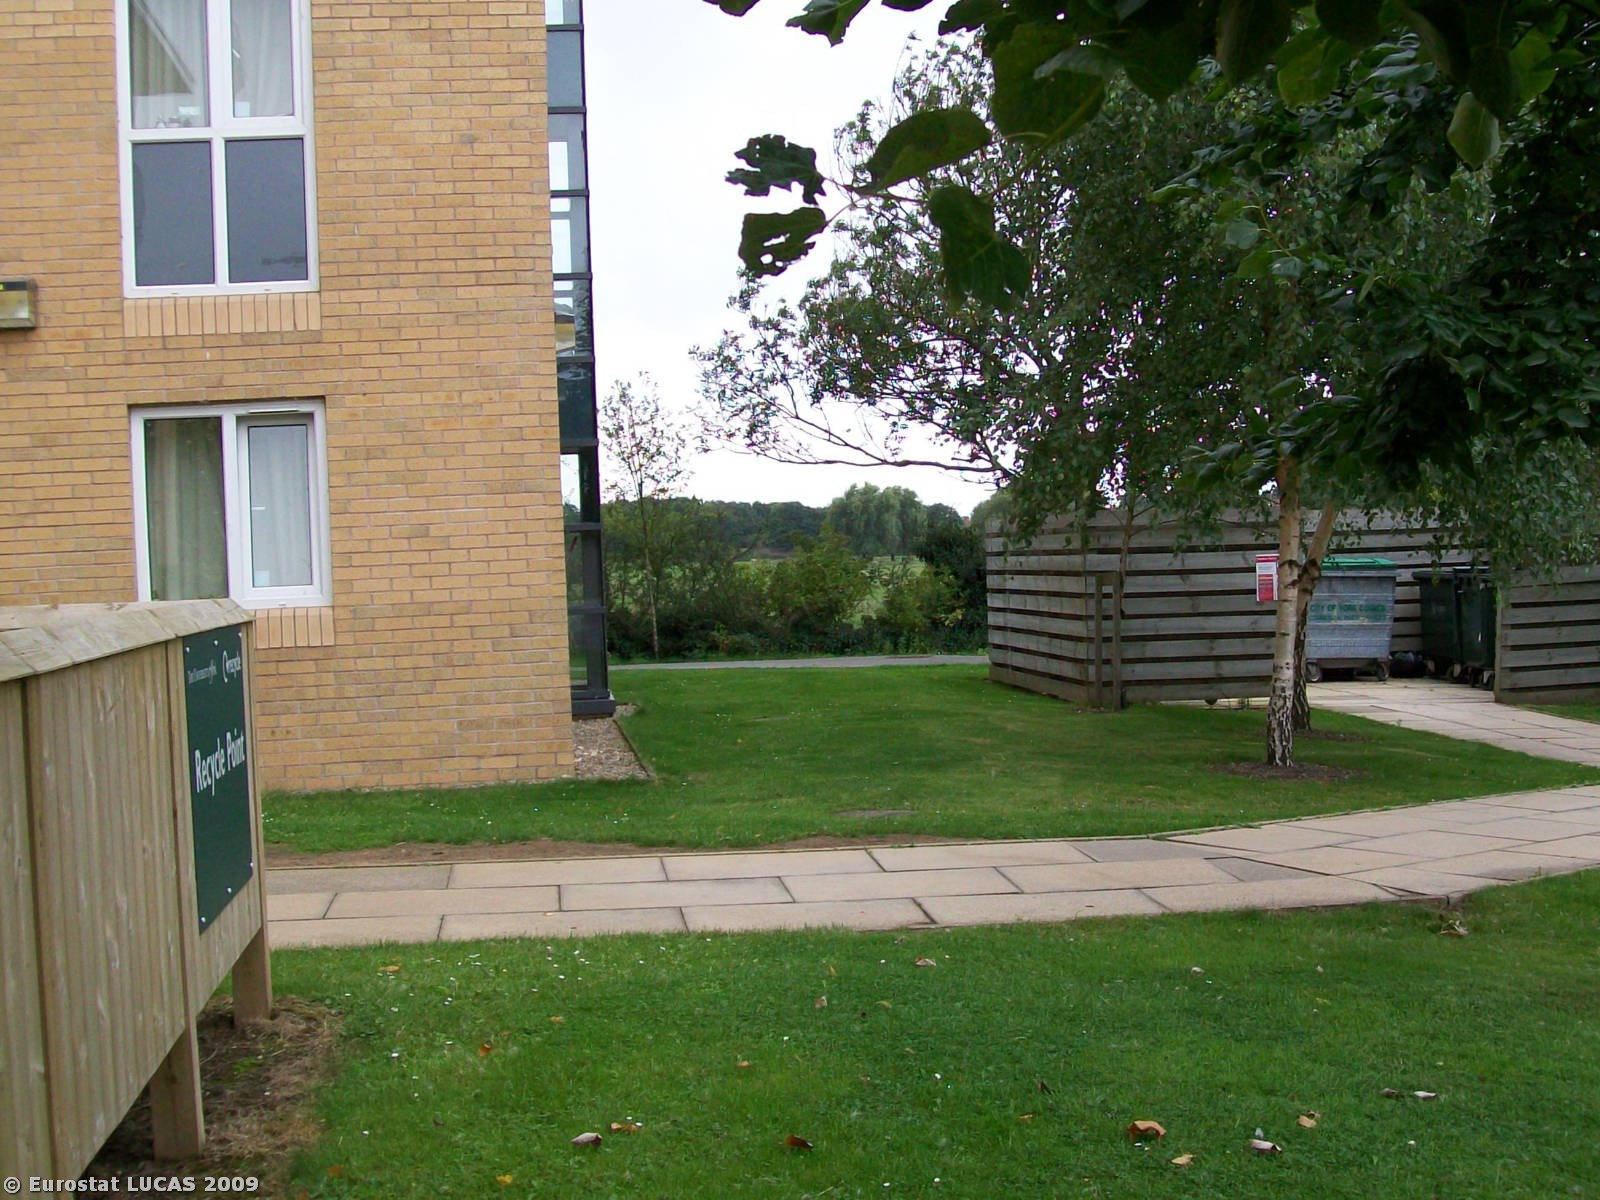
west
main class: Artificial land
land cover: Non built-up linear features
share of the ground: > 75 %
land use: Road transport
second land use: Community services
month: August
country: GB
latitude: 53.9466
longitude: -1.0592
